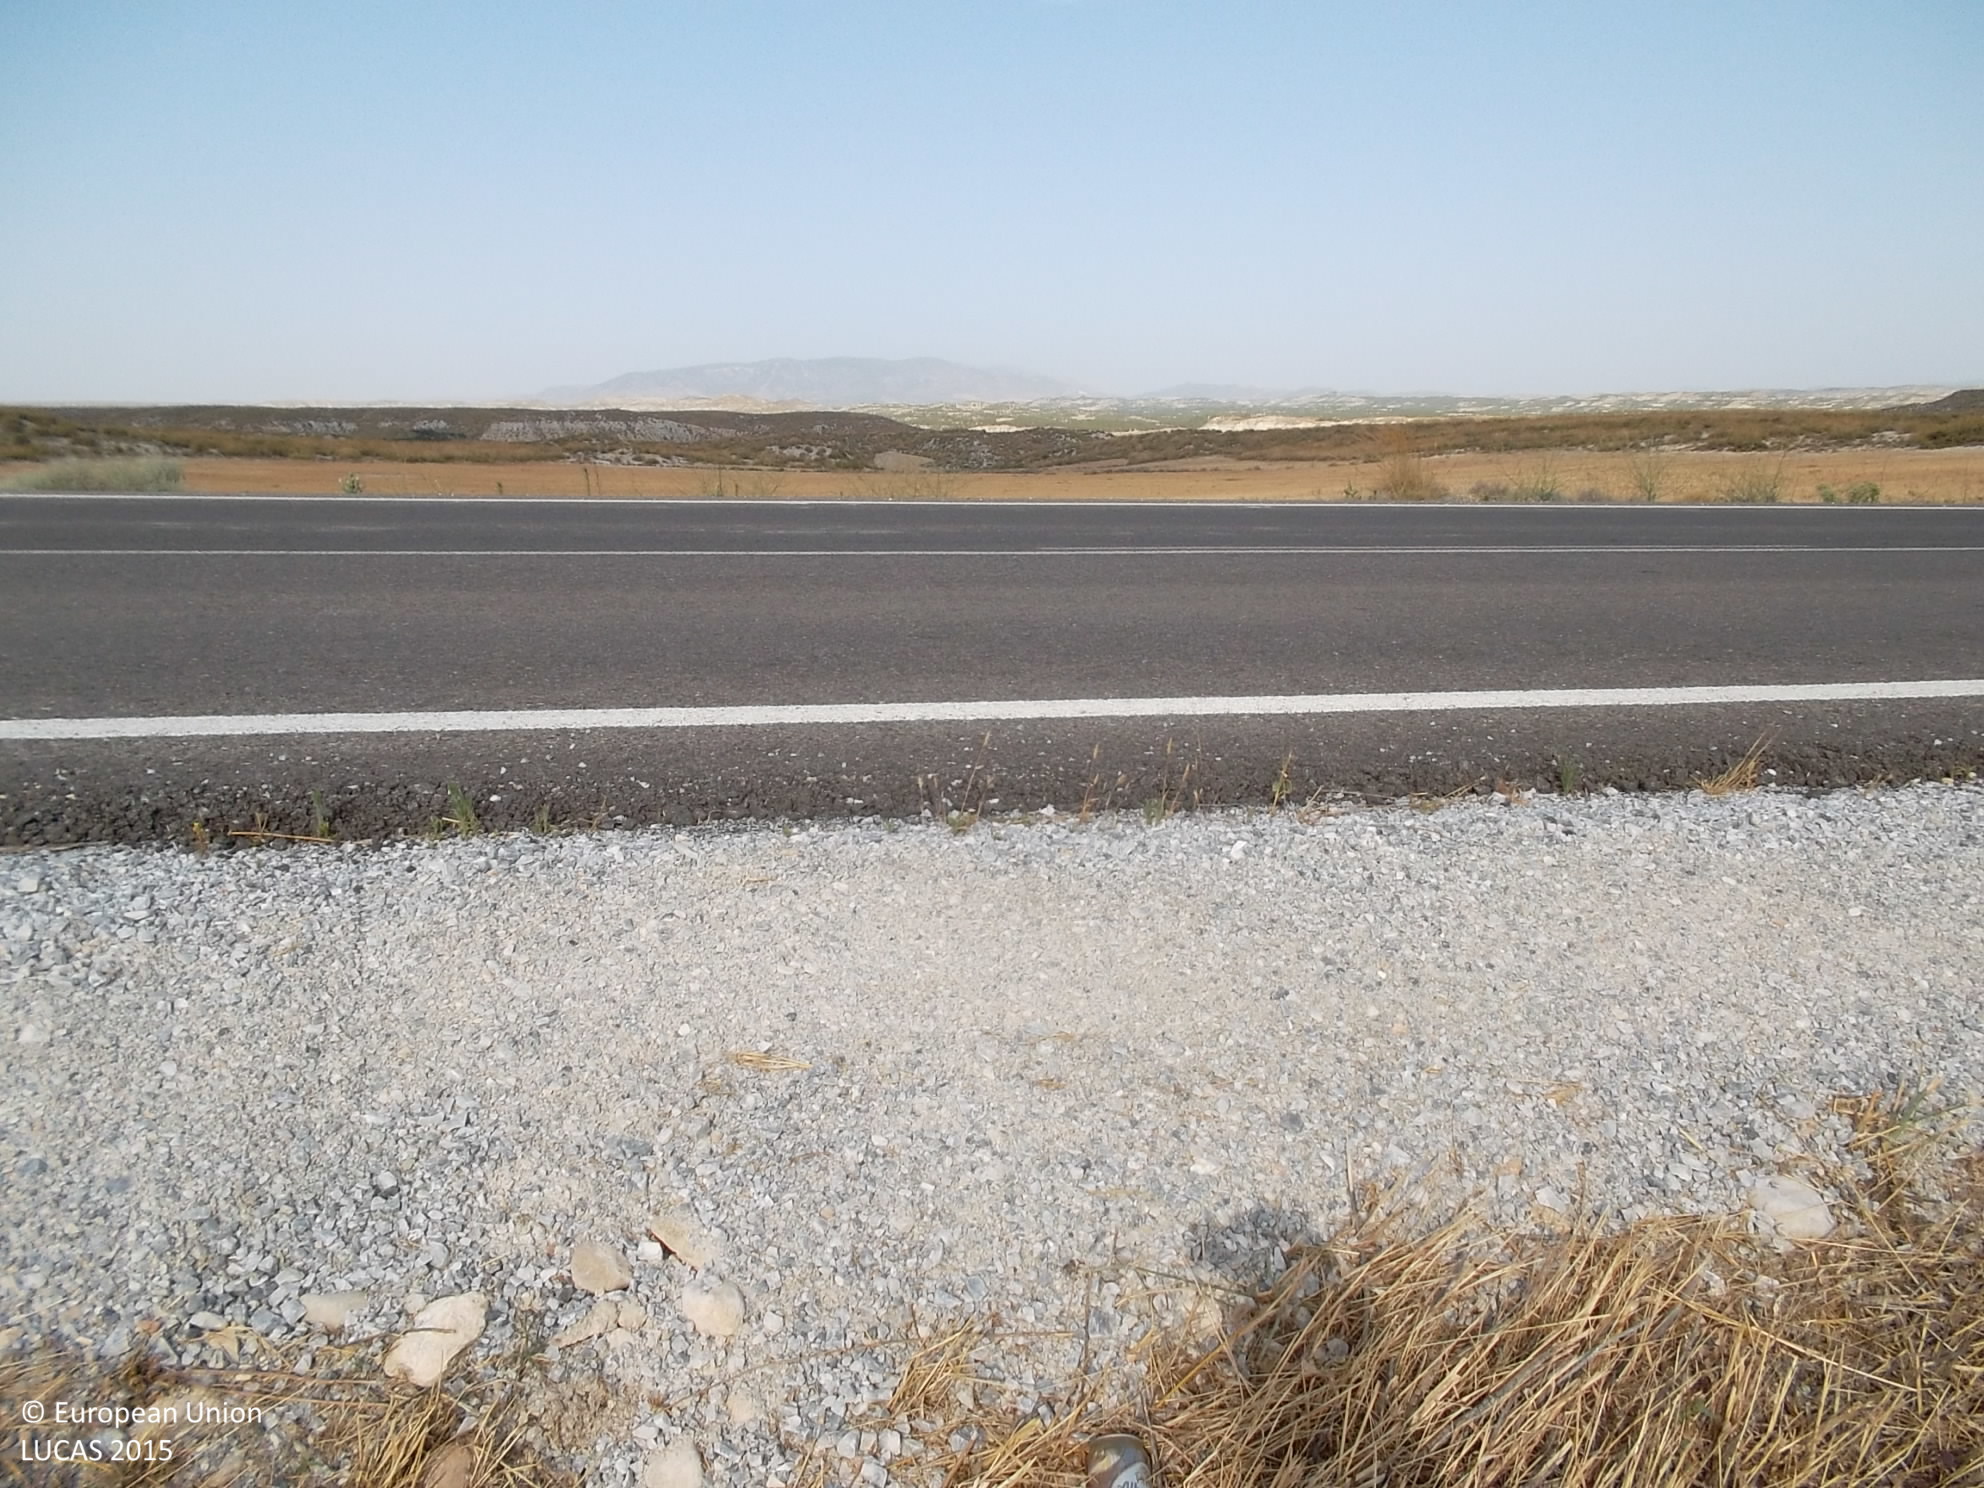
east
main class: Cropland
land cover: Barley
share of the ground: < 10 %
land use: Agriculture (excluding fallow land and kitchen gardens)
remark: Harvested field
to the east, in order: Barley; Grass margins; Paved roads, cycling and walking lanes; Grass margins; Oats; Grass margins; Oats
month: July
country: ES
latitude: 37.6418
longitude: -2.7158
